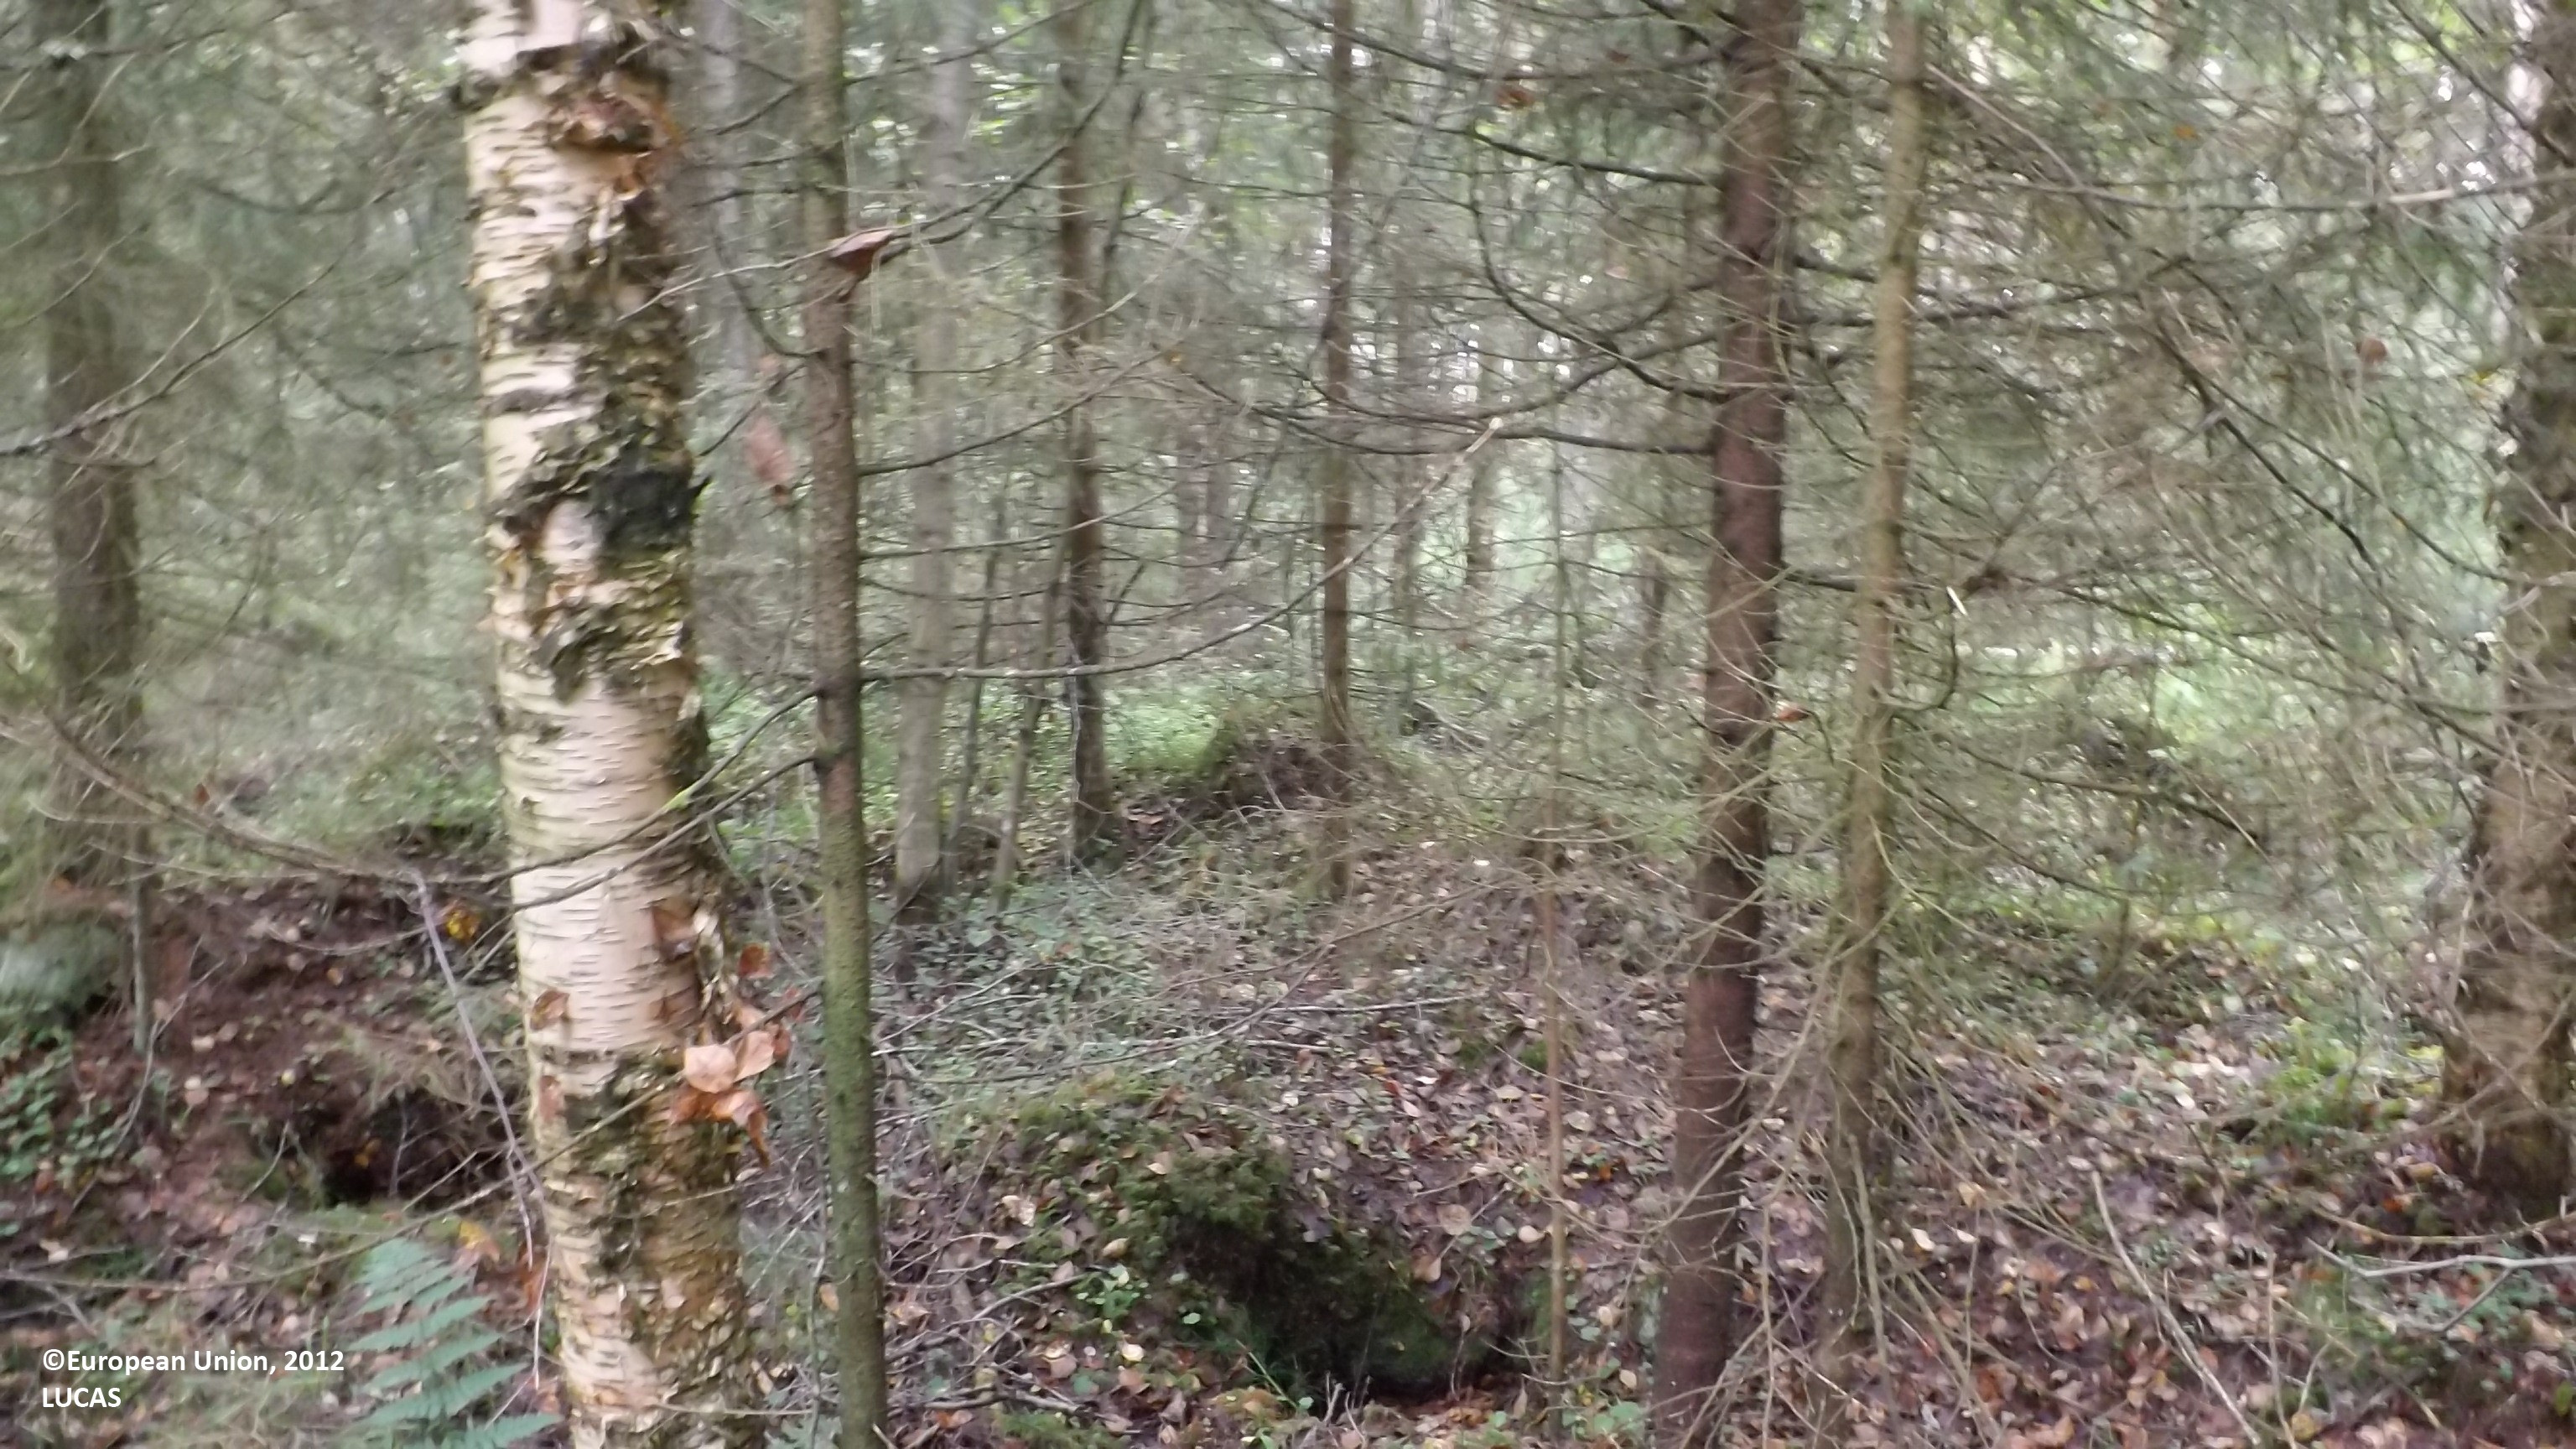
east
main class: Woodland
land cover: Spruce dominated mixed woodland
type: boreal forest
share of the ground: > 75 %
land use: Forestry
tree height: > 5 m
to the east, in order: Spruce dominated mixed woodland; Other coniferous woodland; Broadleaved woodland; Ditches and canals; Broadleaved woodland; Ditches and canals; Spruce dominated mixed woodland; Spruce dominated coniferous woodland; Ditches and canals; Spruce dominated coniferous woodland; Ditches and canals; Spruce dominated coniferous woodland
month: August
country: FI
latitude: 63.8437
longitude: 23.4156
